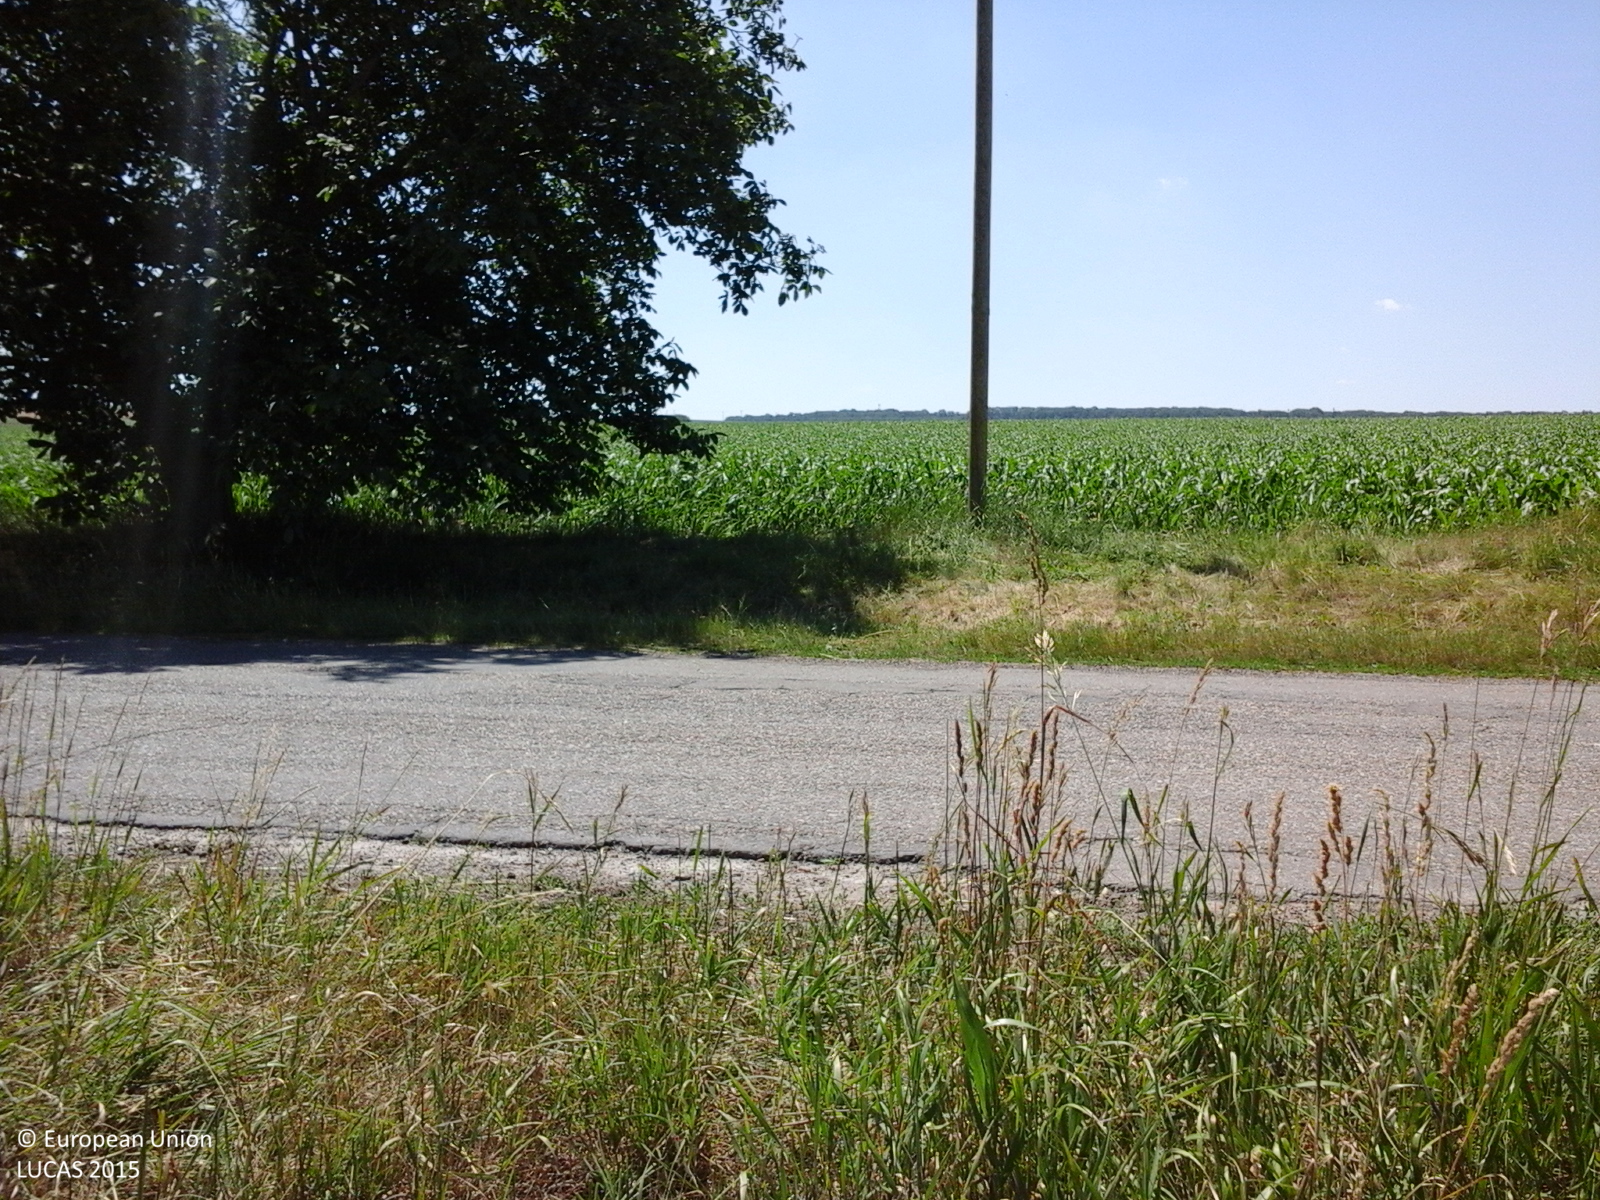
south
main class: Cropland
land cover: Sunflower
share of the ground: > 75 %
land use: Agriculture (excluding fallow land and kitchen gardens)
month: June
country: RO
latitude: 47.9761
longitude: 27.1096
